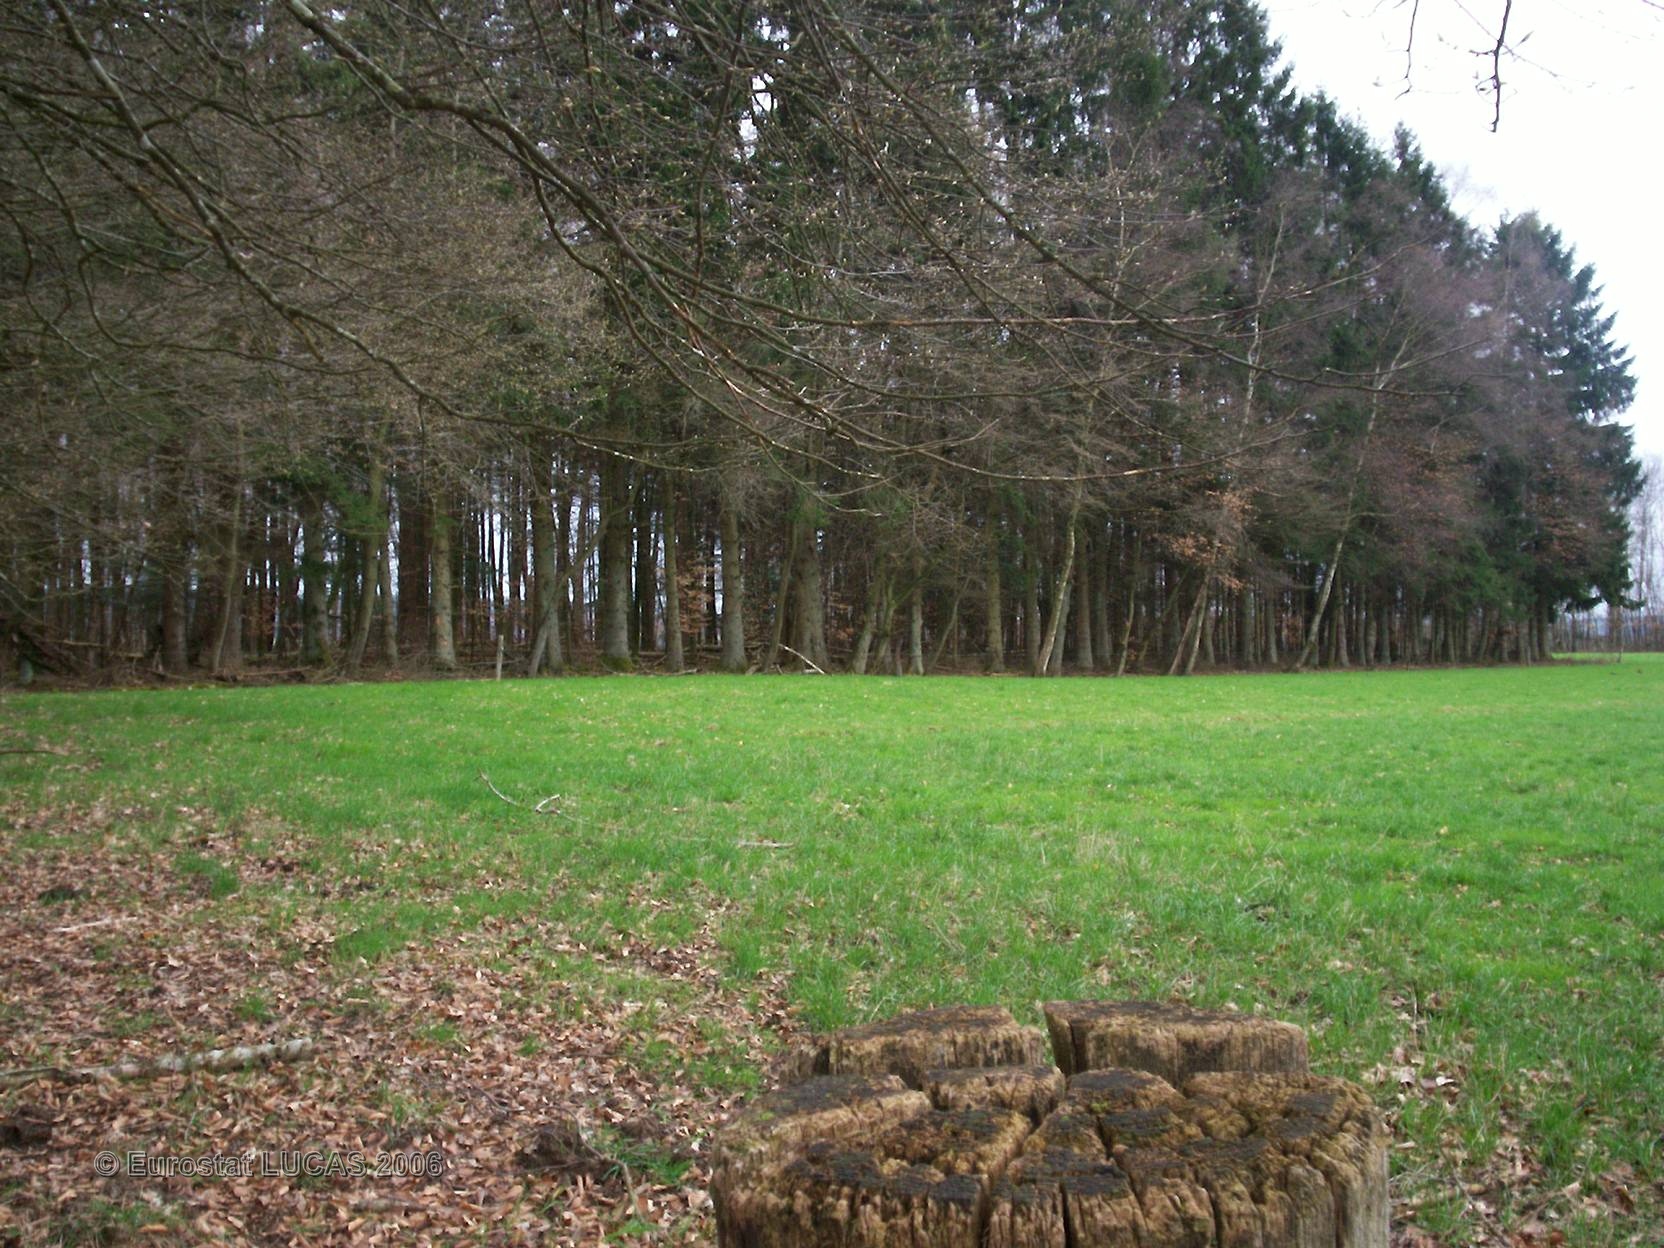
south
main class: Woodland
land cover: Broadleaved forest
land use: Forestry
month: April
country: FR
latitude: 48.0160
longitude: 6.2603
